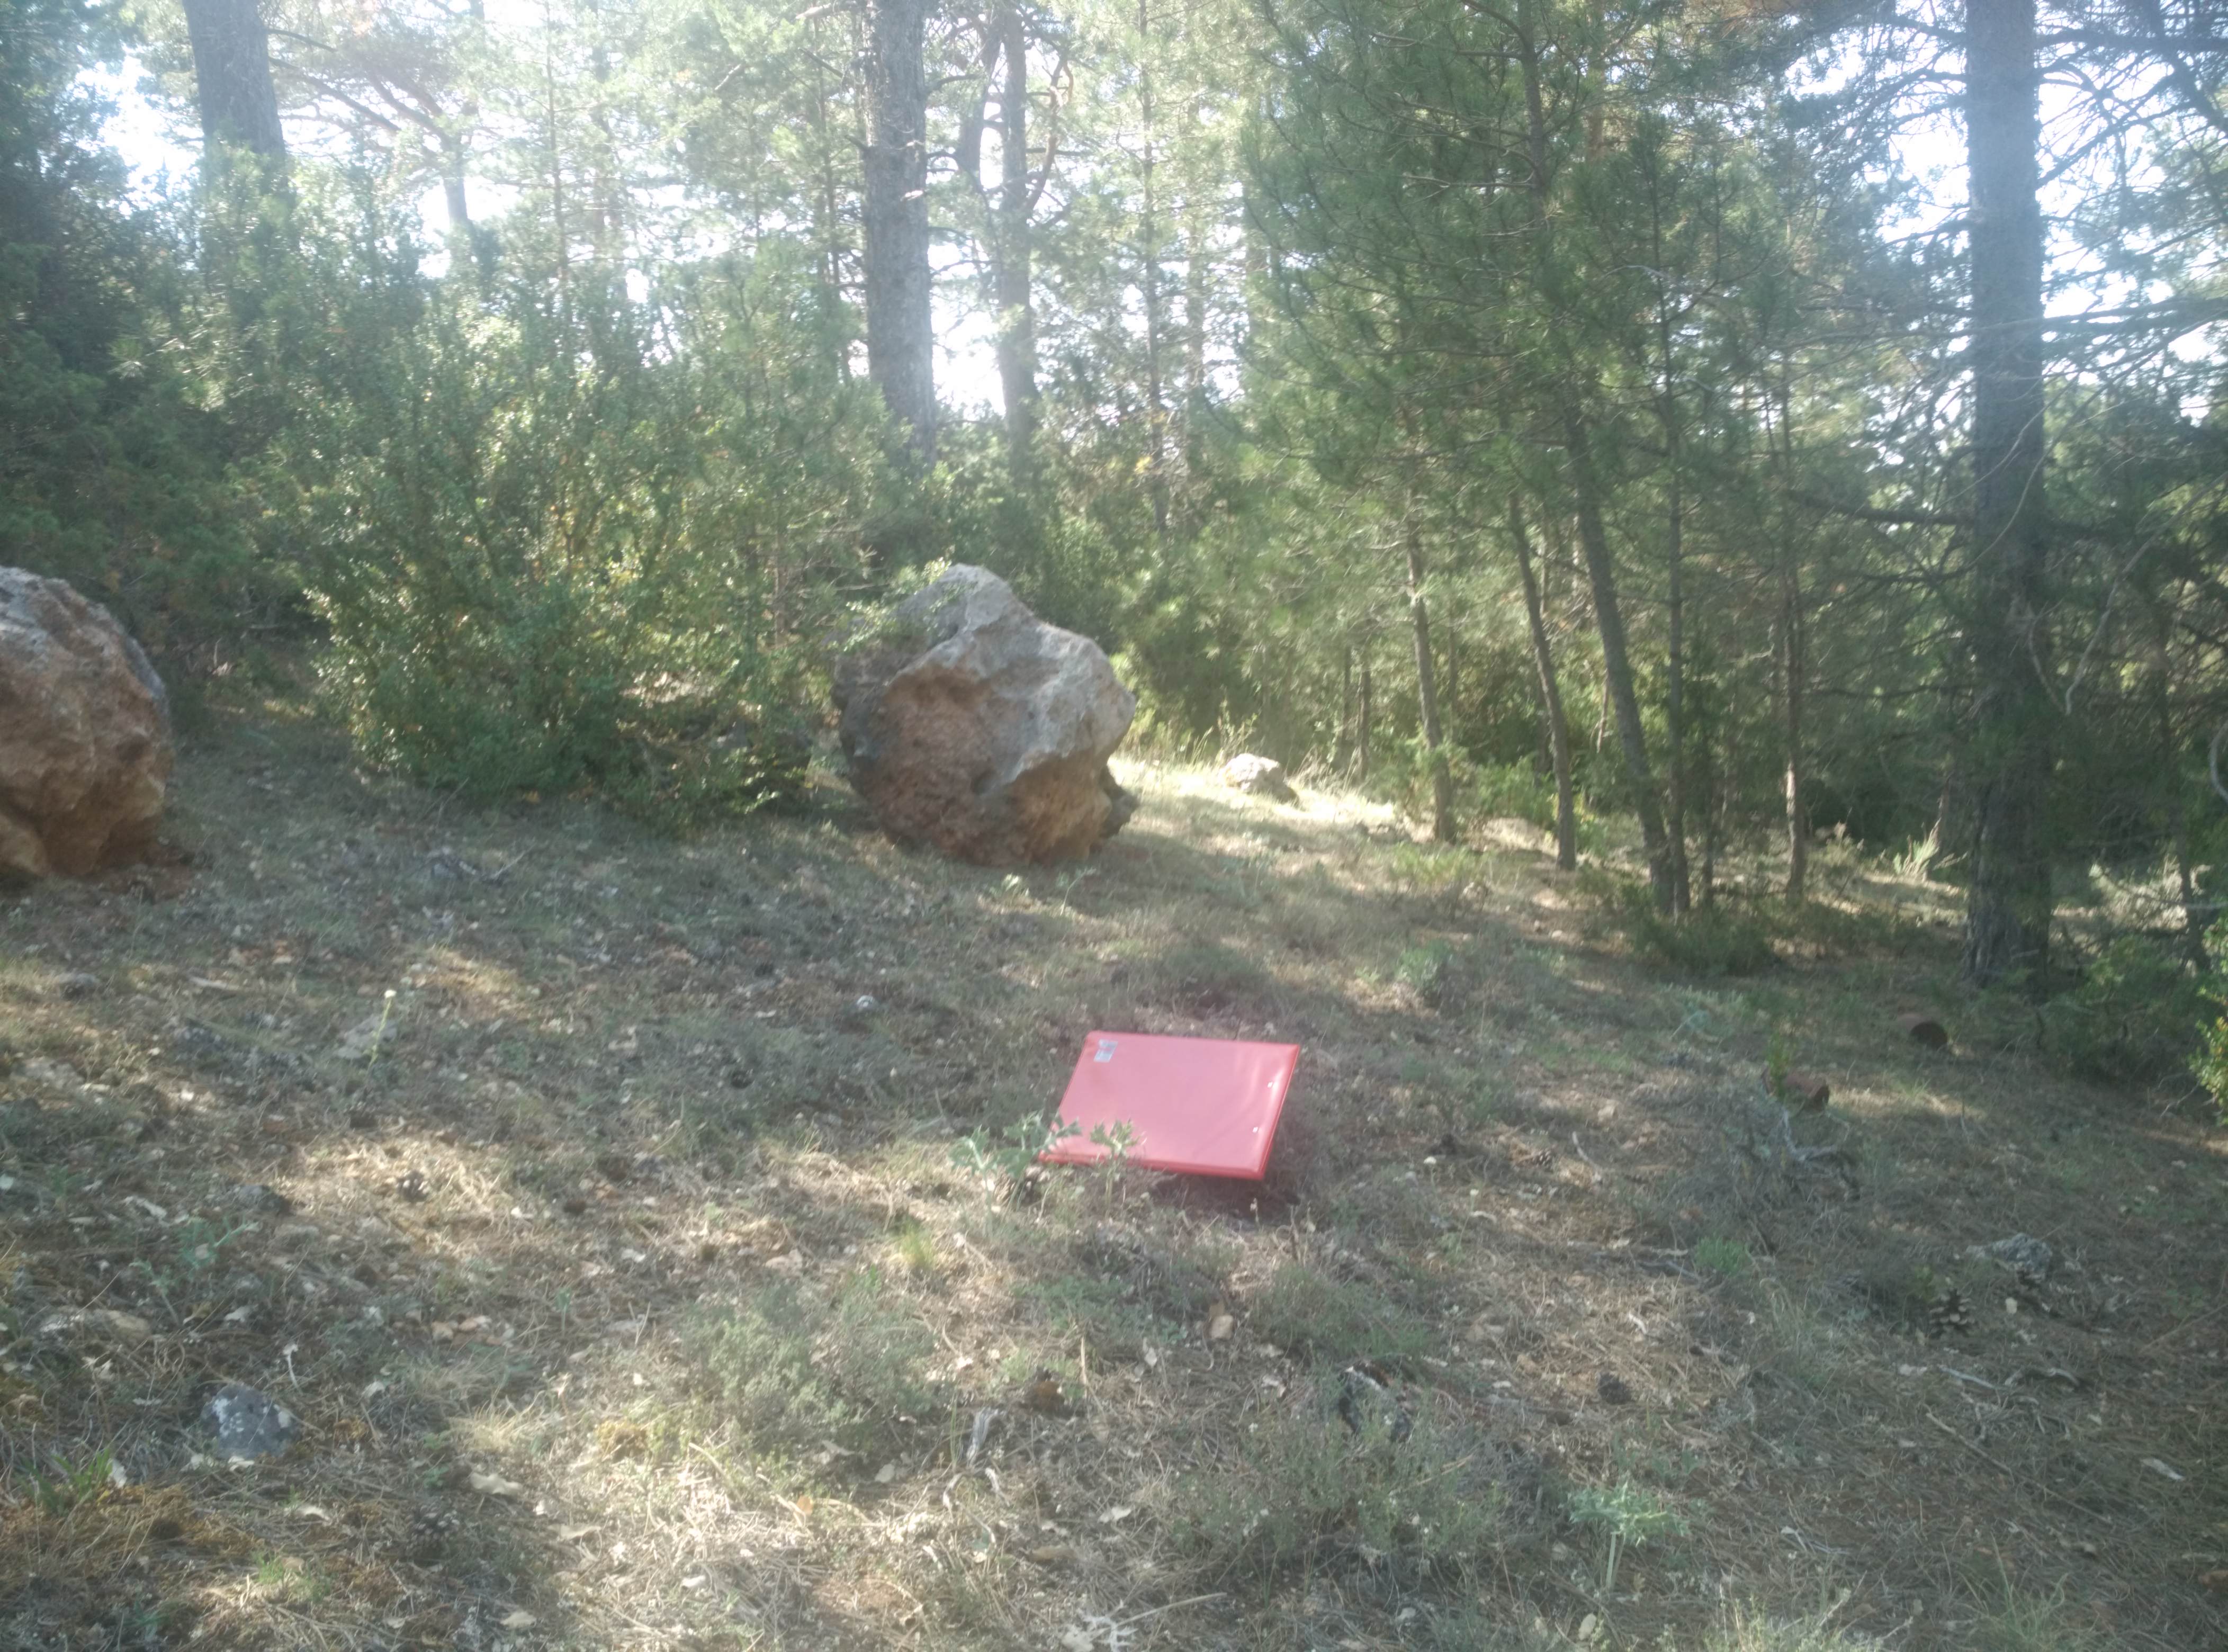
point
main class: Woodland
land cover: Pine dominated coniferous woodland
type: coniferous forest of the mediterranean region
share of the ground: 25 - 50 %
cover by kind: coniferous forest trees 40 %, unconsolidated bare surface 40 %, shrubs 15 %, herbaceous plants 5 %
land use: Semi-natural and natural areas not in use
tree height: > 5 m
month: June
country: ES
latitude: 40.6264
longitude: -1.8295
